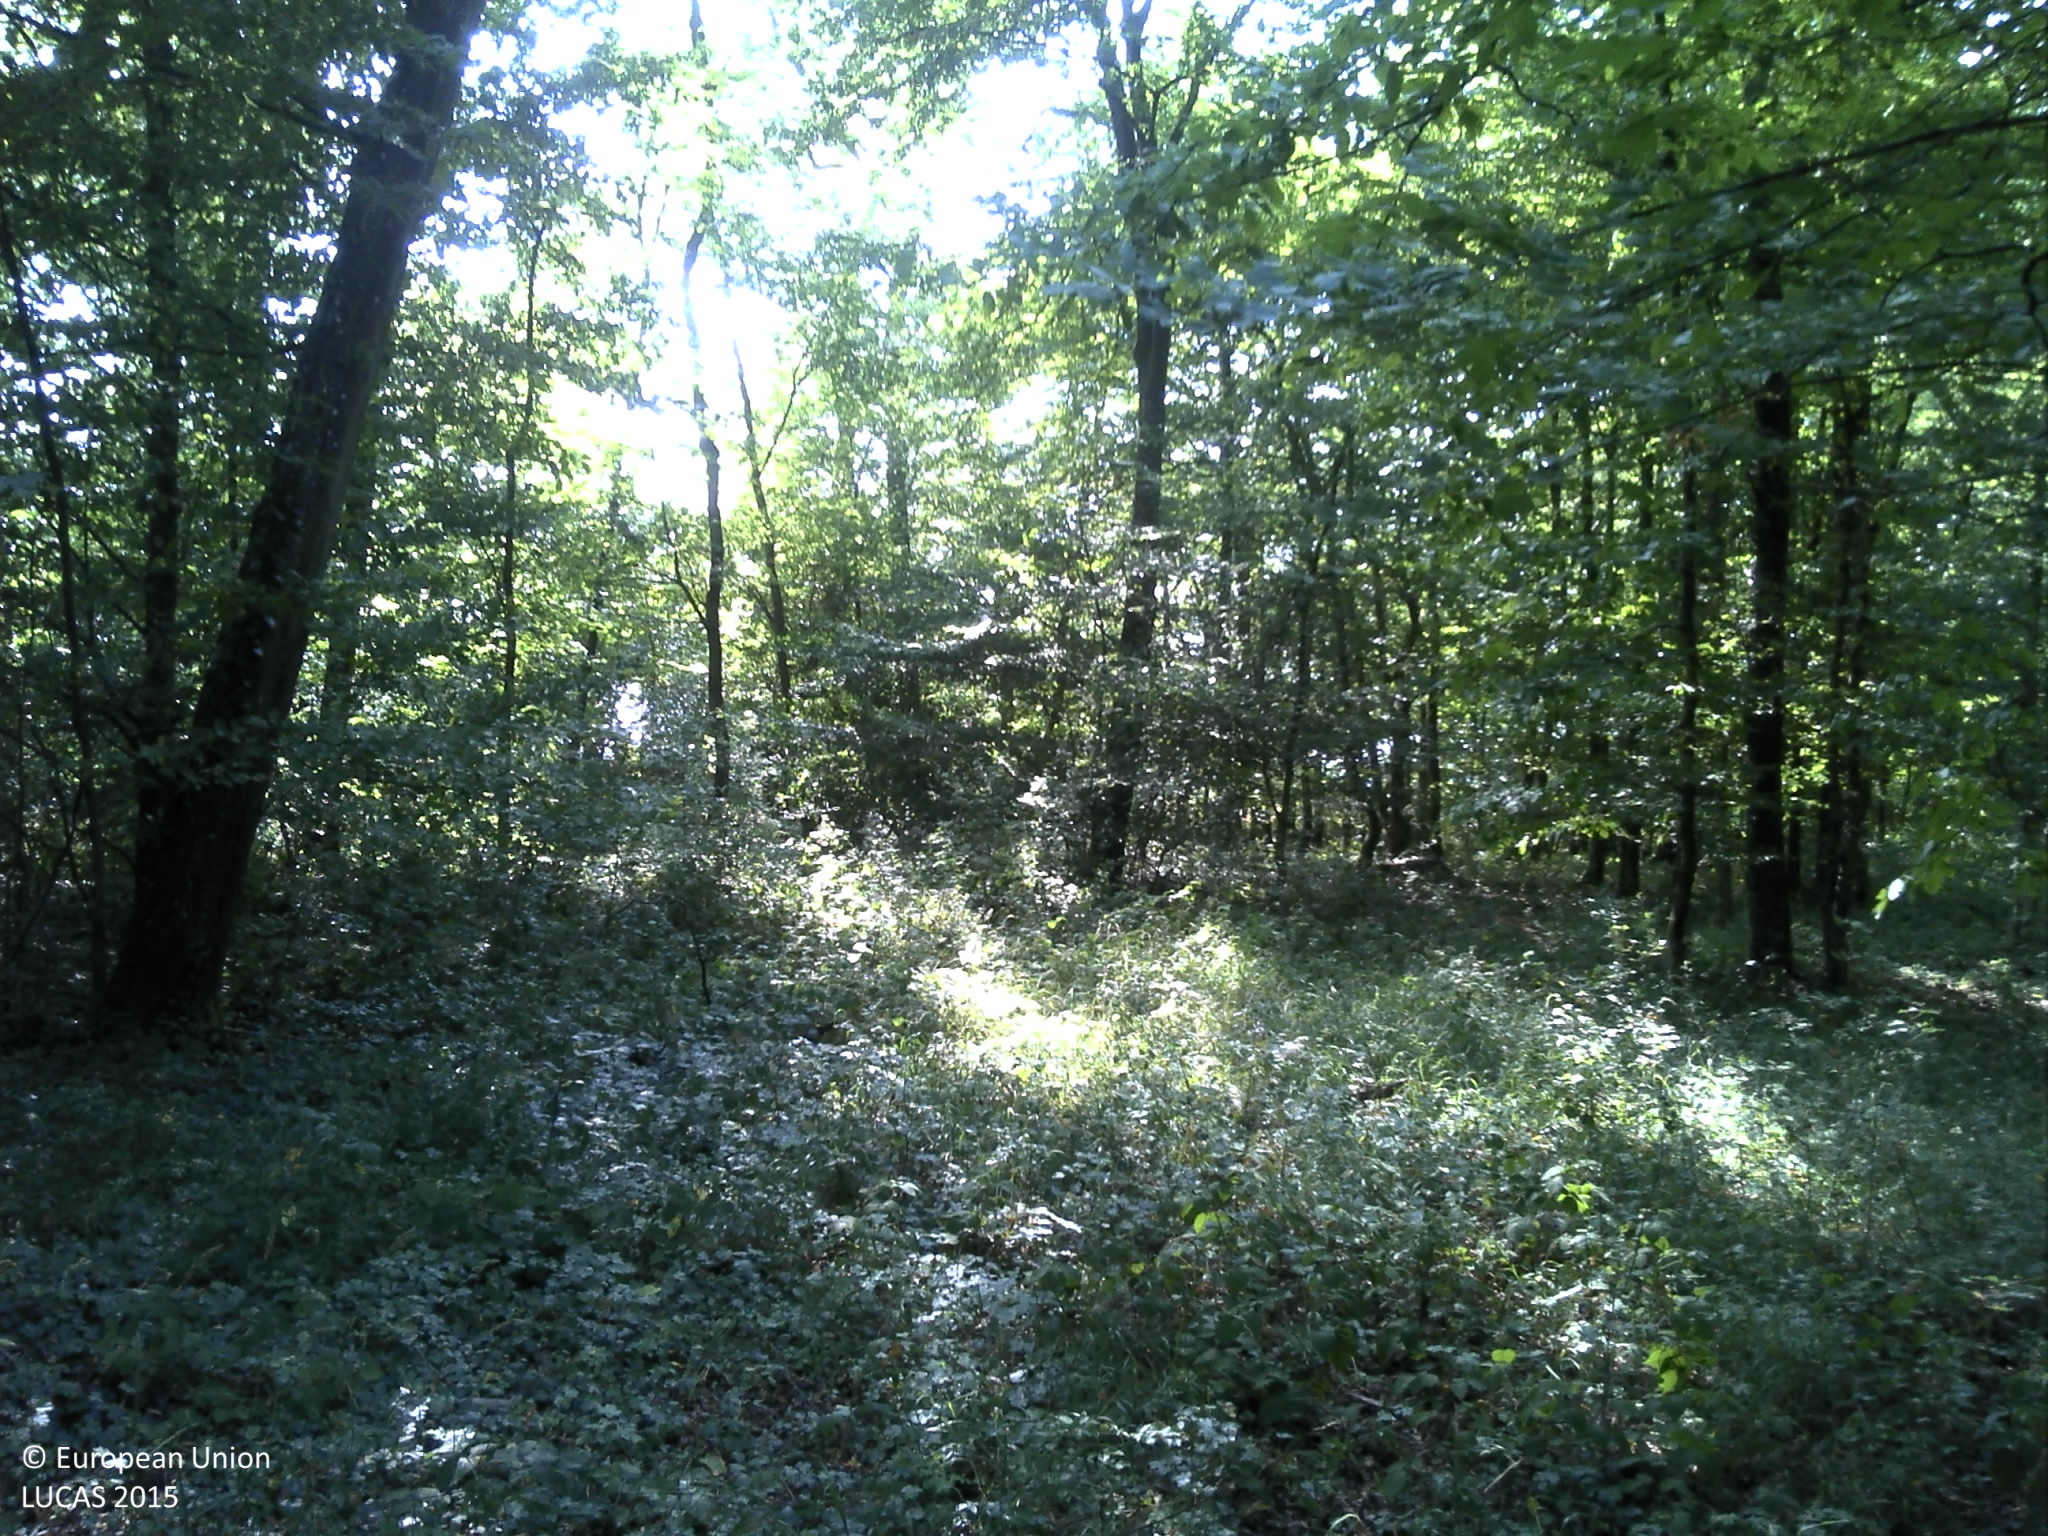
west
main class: Woodland
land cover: Broadleaved woodland
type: acidophilous oak and oak-birch forest
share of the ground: > 75 %
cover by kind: broadleaved forest trees 100 %
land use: Forestry
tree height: > 5 m
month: July
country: FR
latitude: 48.9340
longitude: 6.8197
